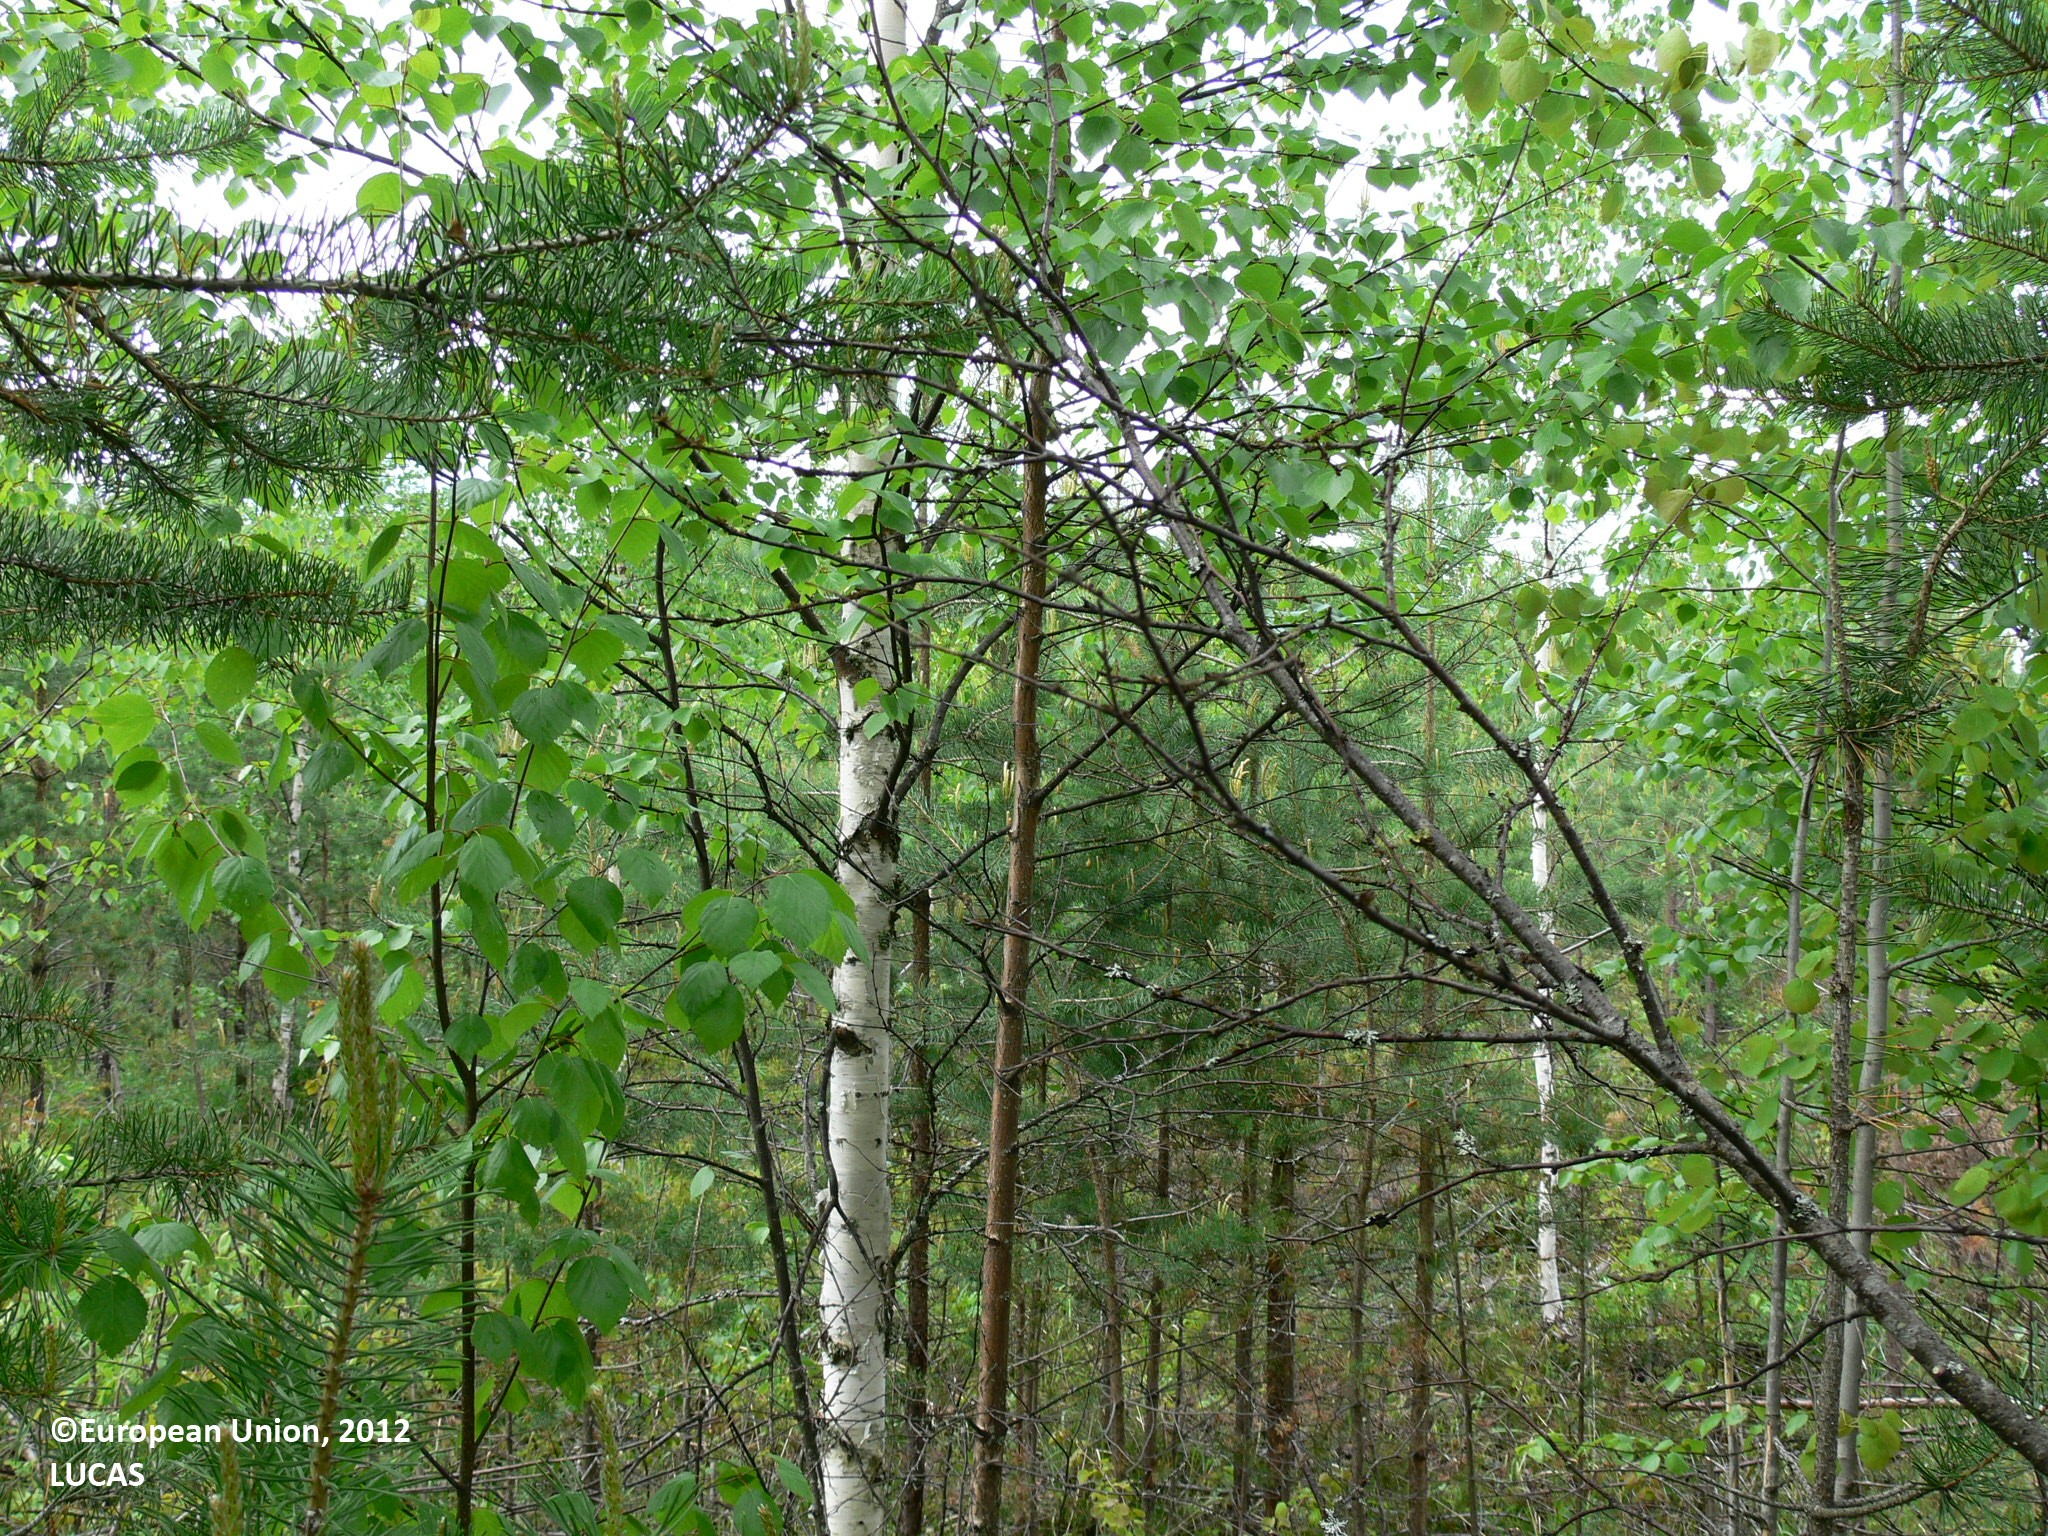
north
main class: Woodland
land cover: Other mixed woodland
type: boreal forest
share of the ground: 50 - 75 %
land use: Forestry
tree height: > 5 m
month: June
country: FI
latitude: 62.4256
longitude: 30.2768
